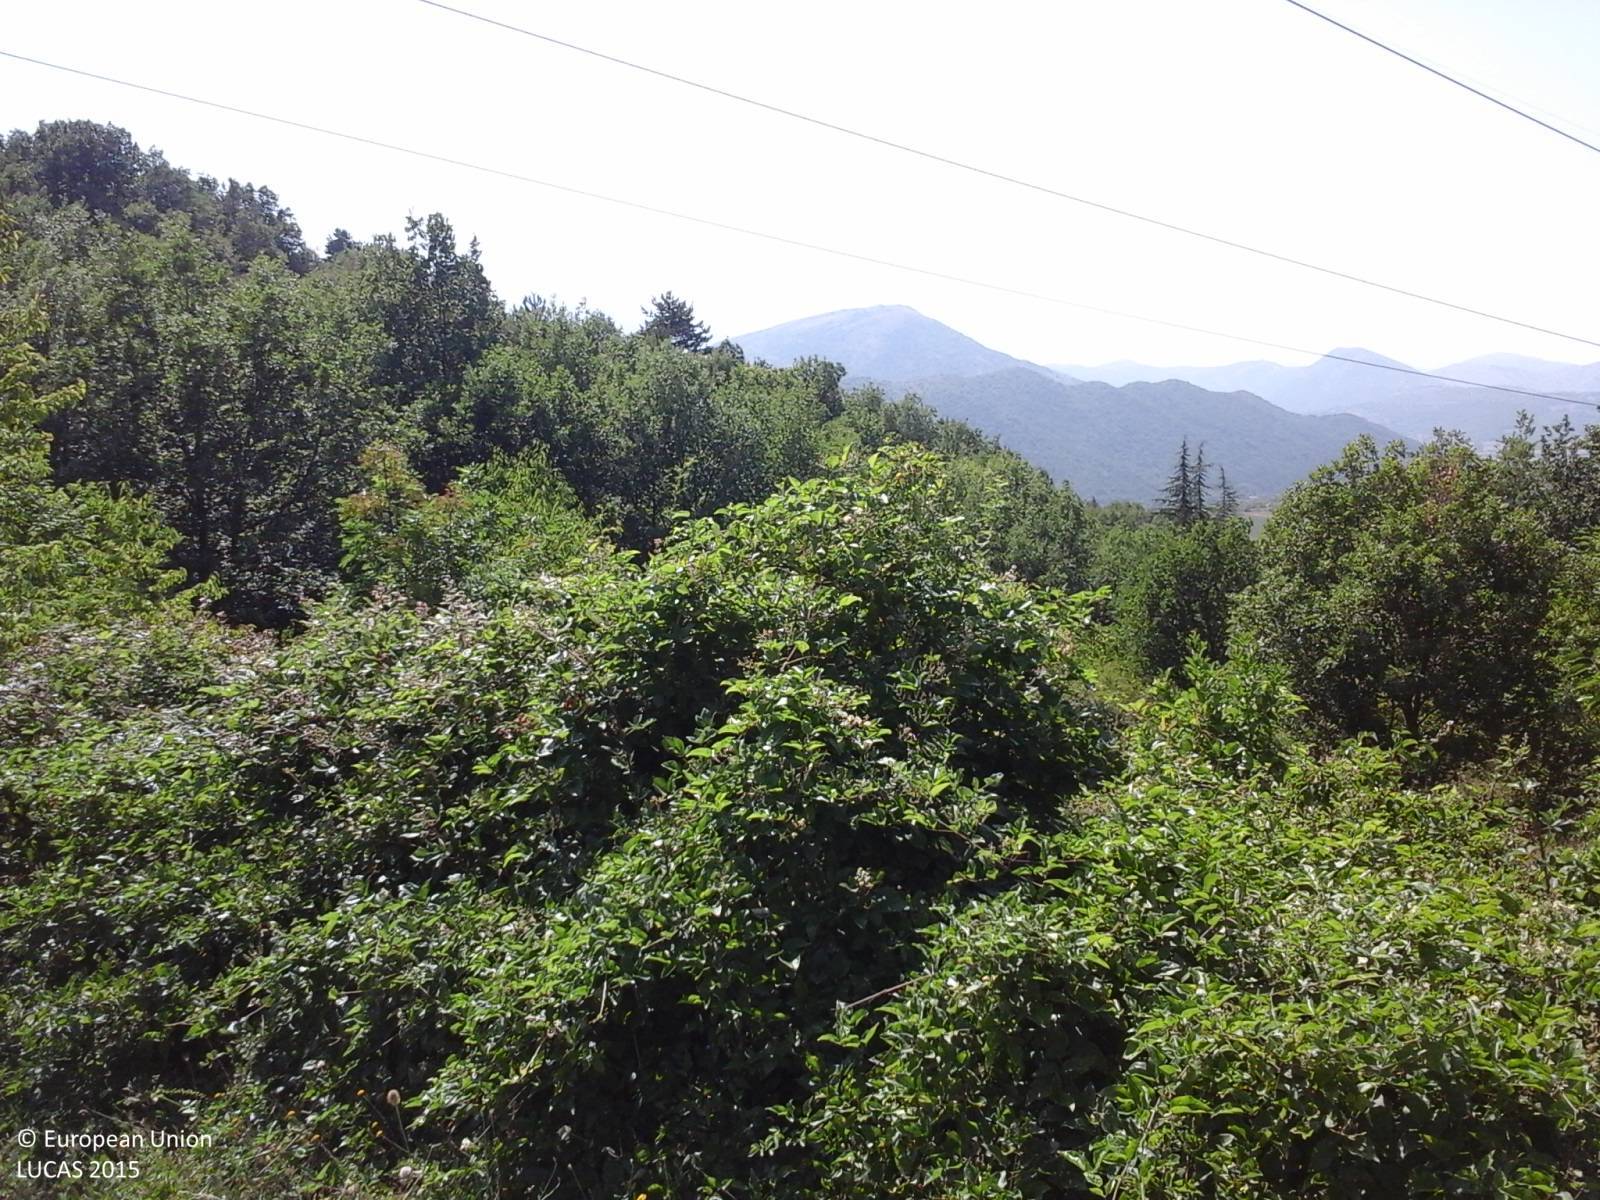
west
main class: Woodland
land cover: Broadleaved woodland
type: thermophilous deciduous forest
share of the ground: > 75 %
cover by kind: broadleaved forest trees 85 %, shrubs 10 %, coniferous forest trees 5 %
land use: Forestry
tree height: > 5 m
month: July
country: IT
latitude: 42.4004
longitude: 13.3304
